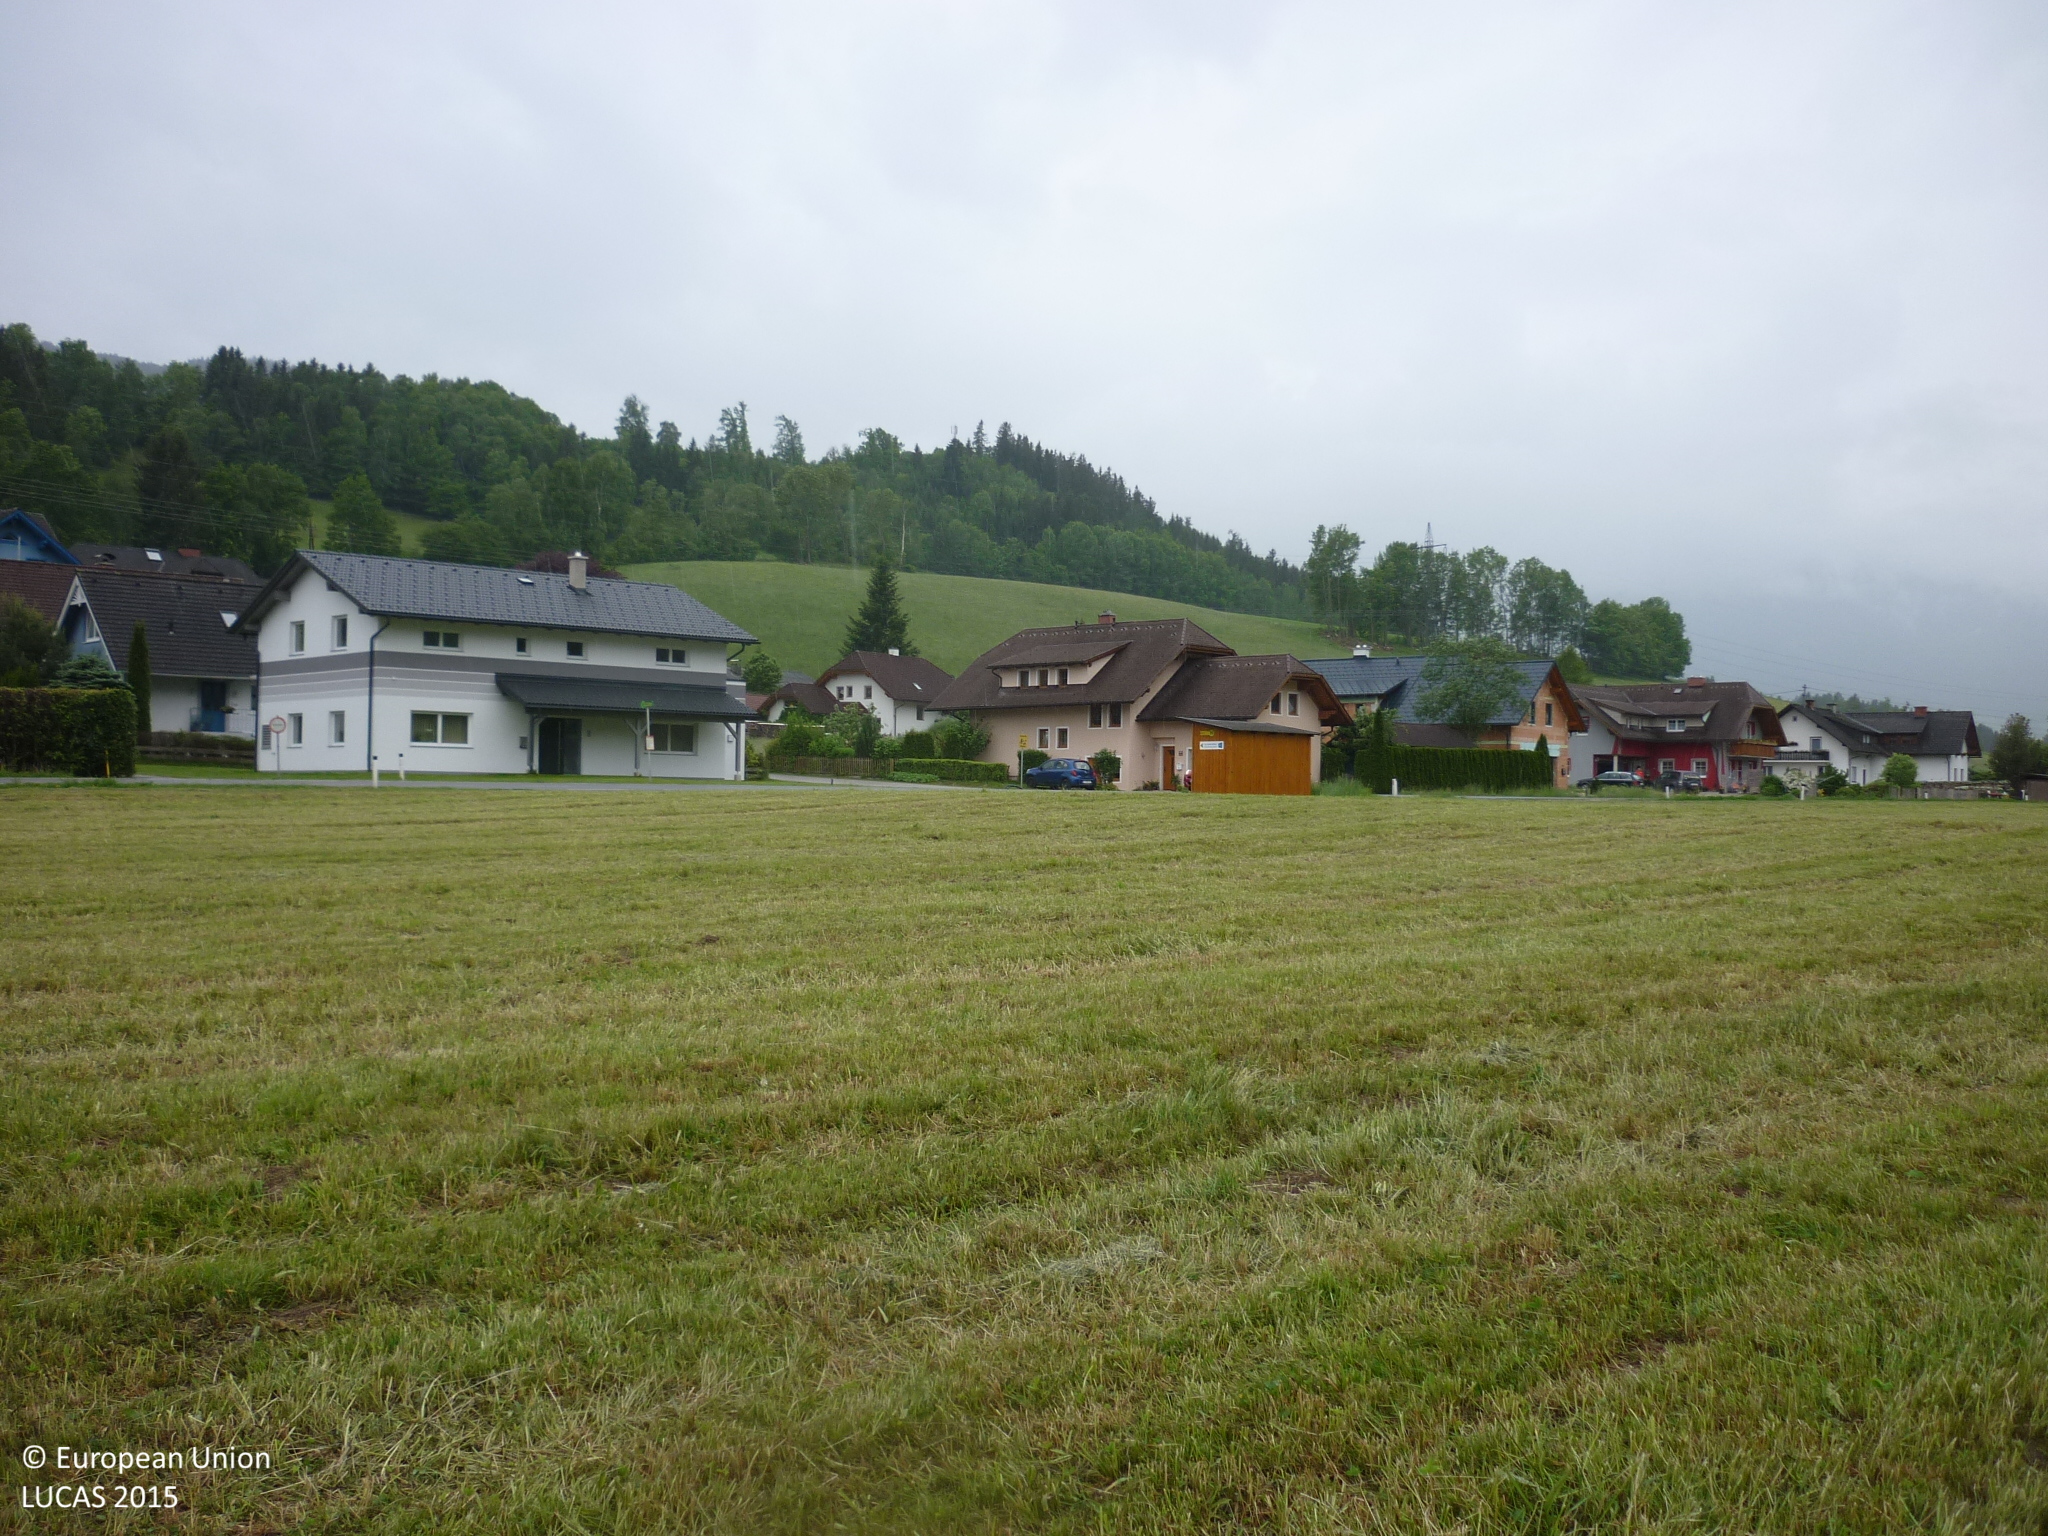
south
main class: Grassland
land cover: Grassland without tree/shrub cover
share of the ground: > 75 %
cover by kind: herbaceous plants 100 %
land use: Agriculture (excluding fallow land and kitchen gardens)
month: May
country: AT
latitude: 47.5155
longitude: 14.1286
